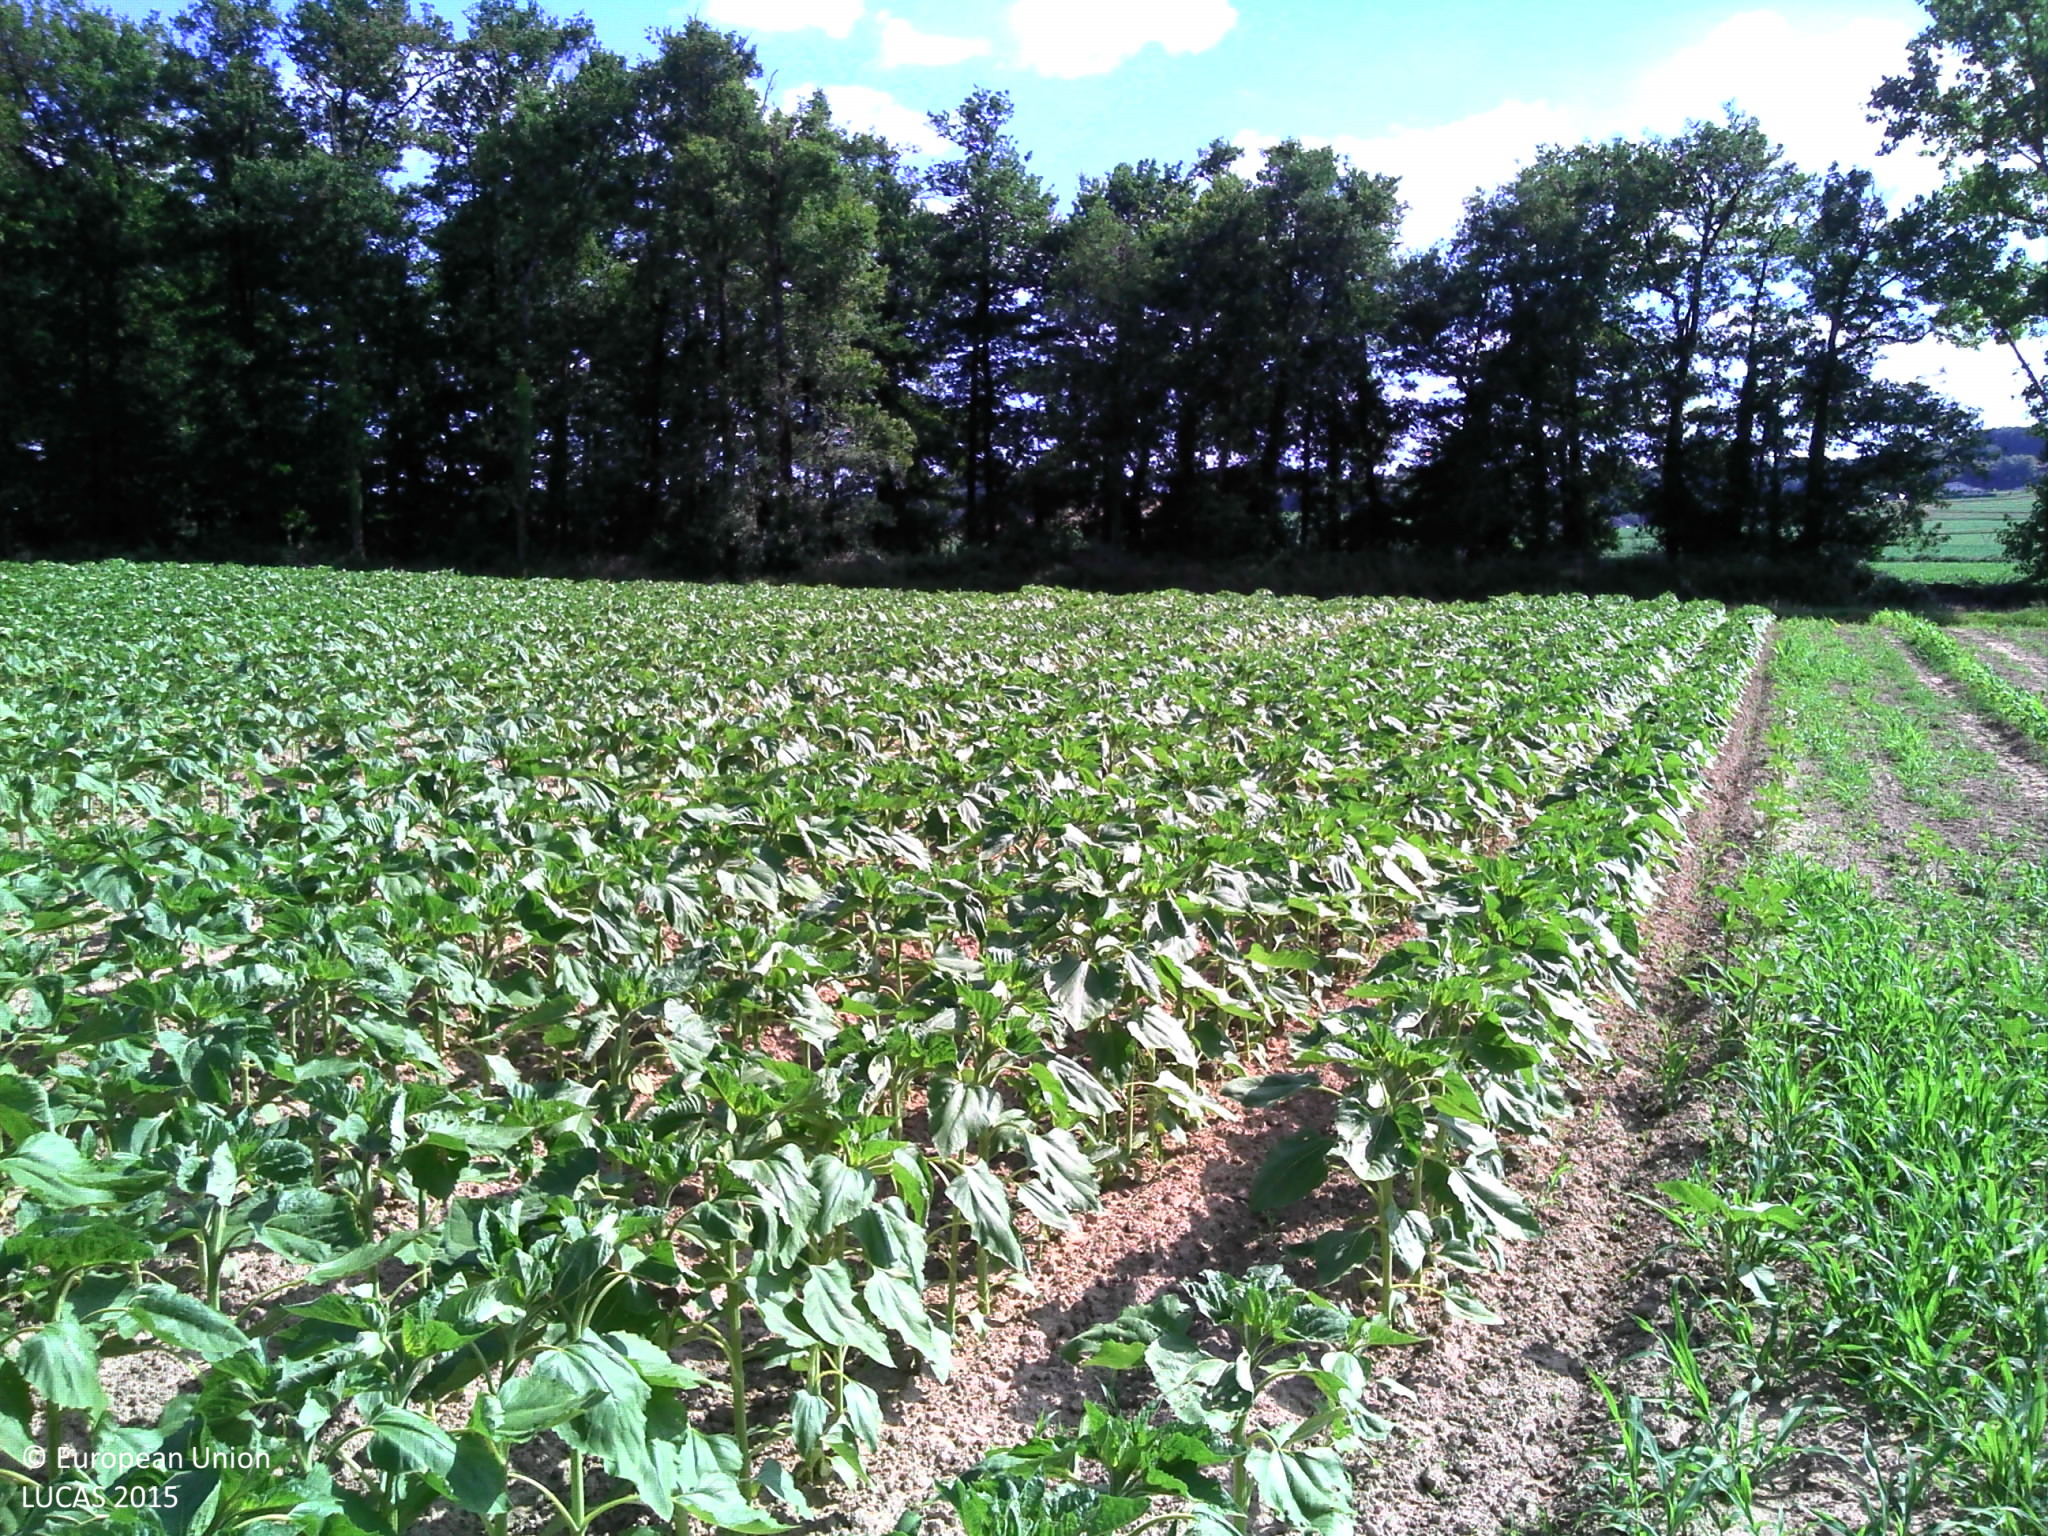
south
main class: Cropland
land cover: Sunflower
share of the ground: 50 - 75 %
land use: Agriculture (excluding fallow land and kitchen gardens)
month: June
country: FR
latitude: 43.6745
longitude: -0.4661
